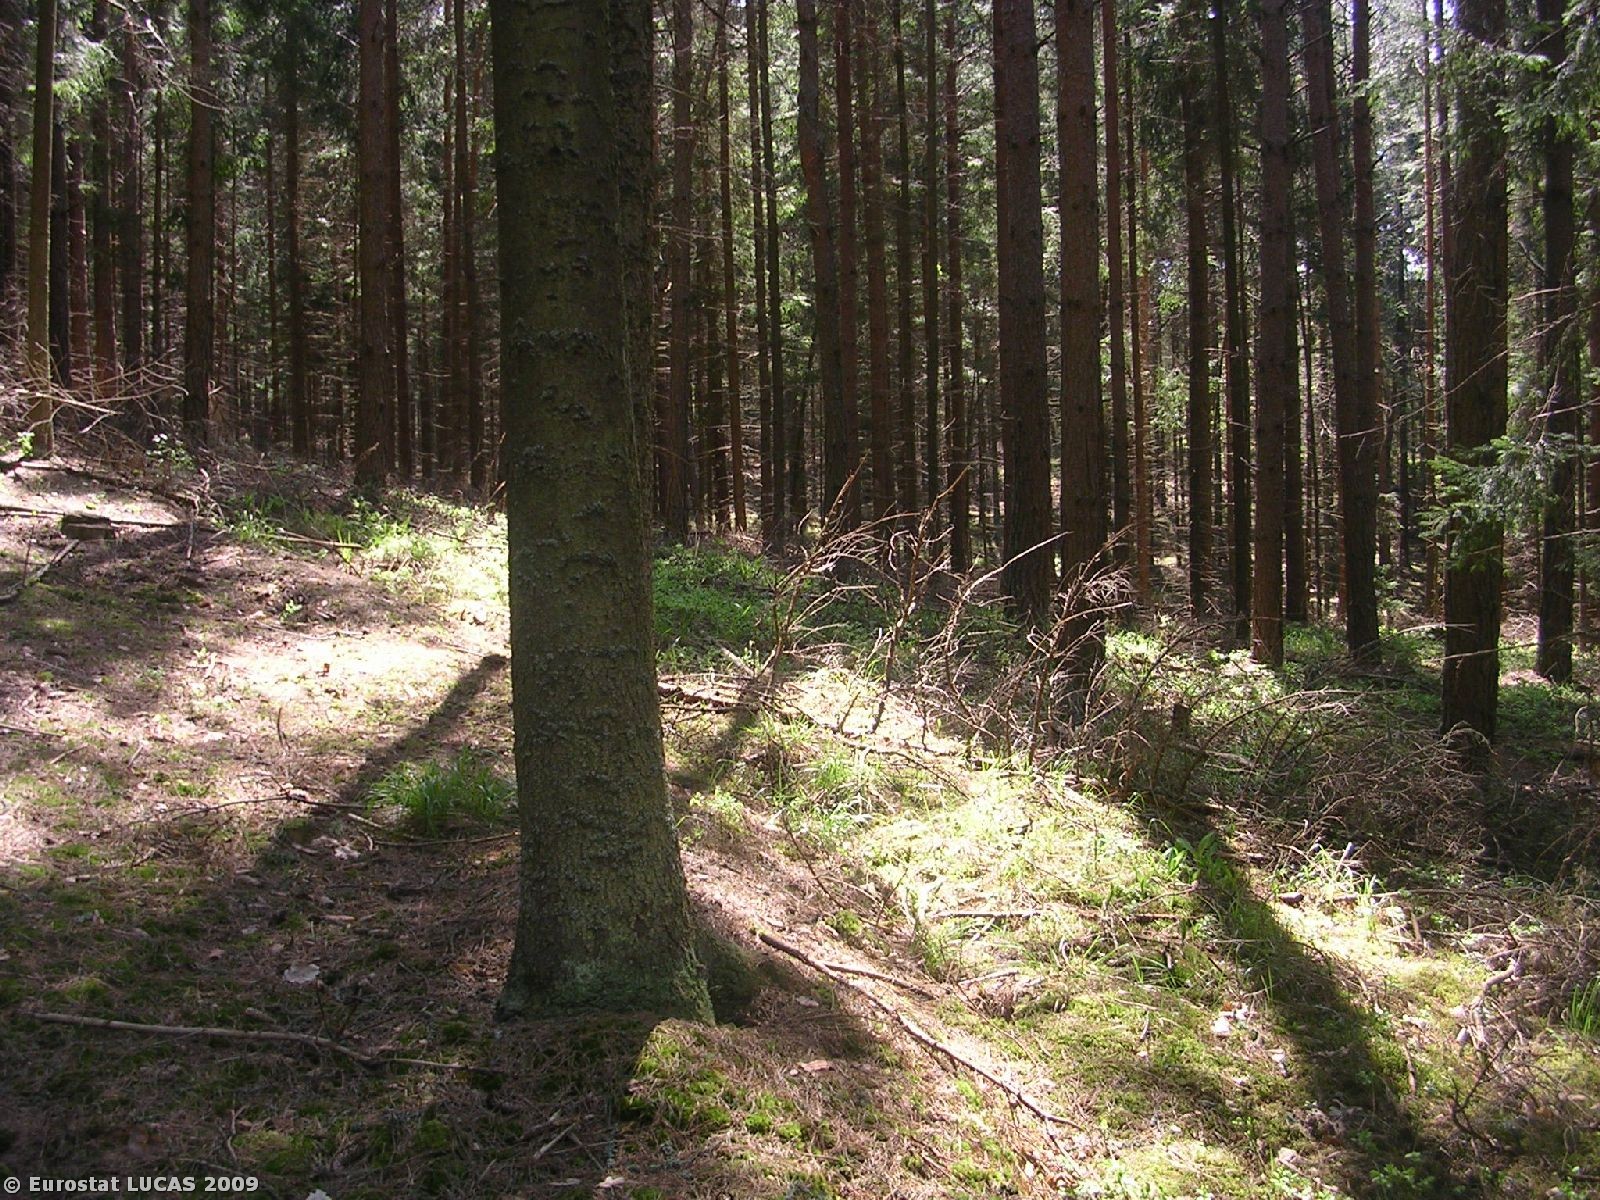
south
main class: Woodland
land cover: Mixed woodland
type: hemiboreal forest and nemoral coniferous forest and mixed broadleaved-coniferous forest
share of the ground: 50 - 75 %
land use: Forestry
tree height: > 5 m
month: May
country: PL
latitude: 53.2219
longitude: 23.3664
